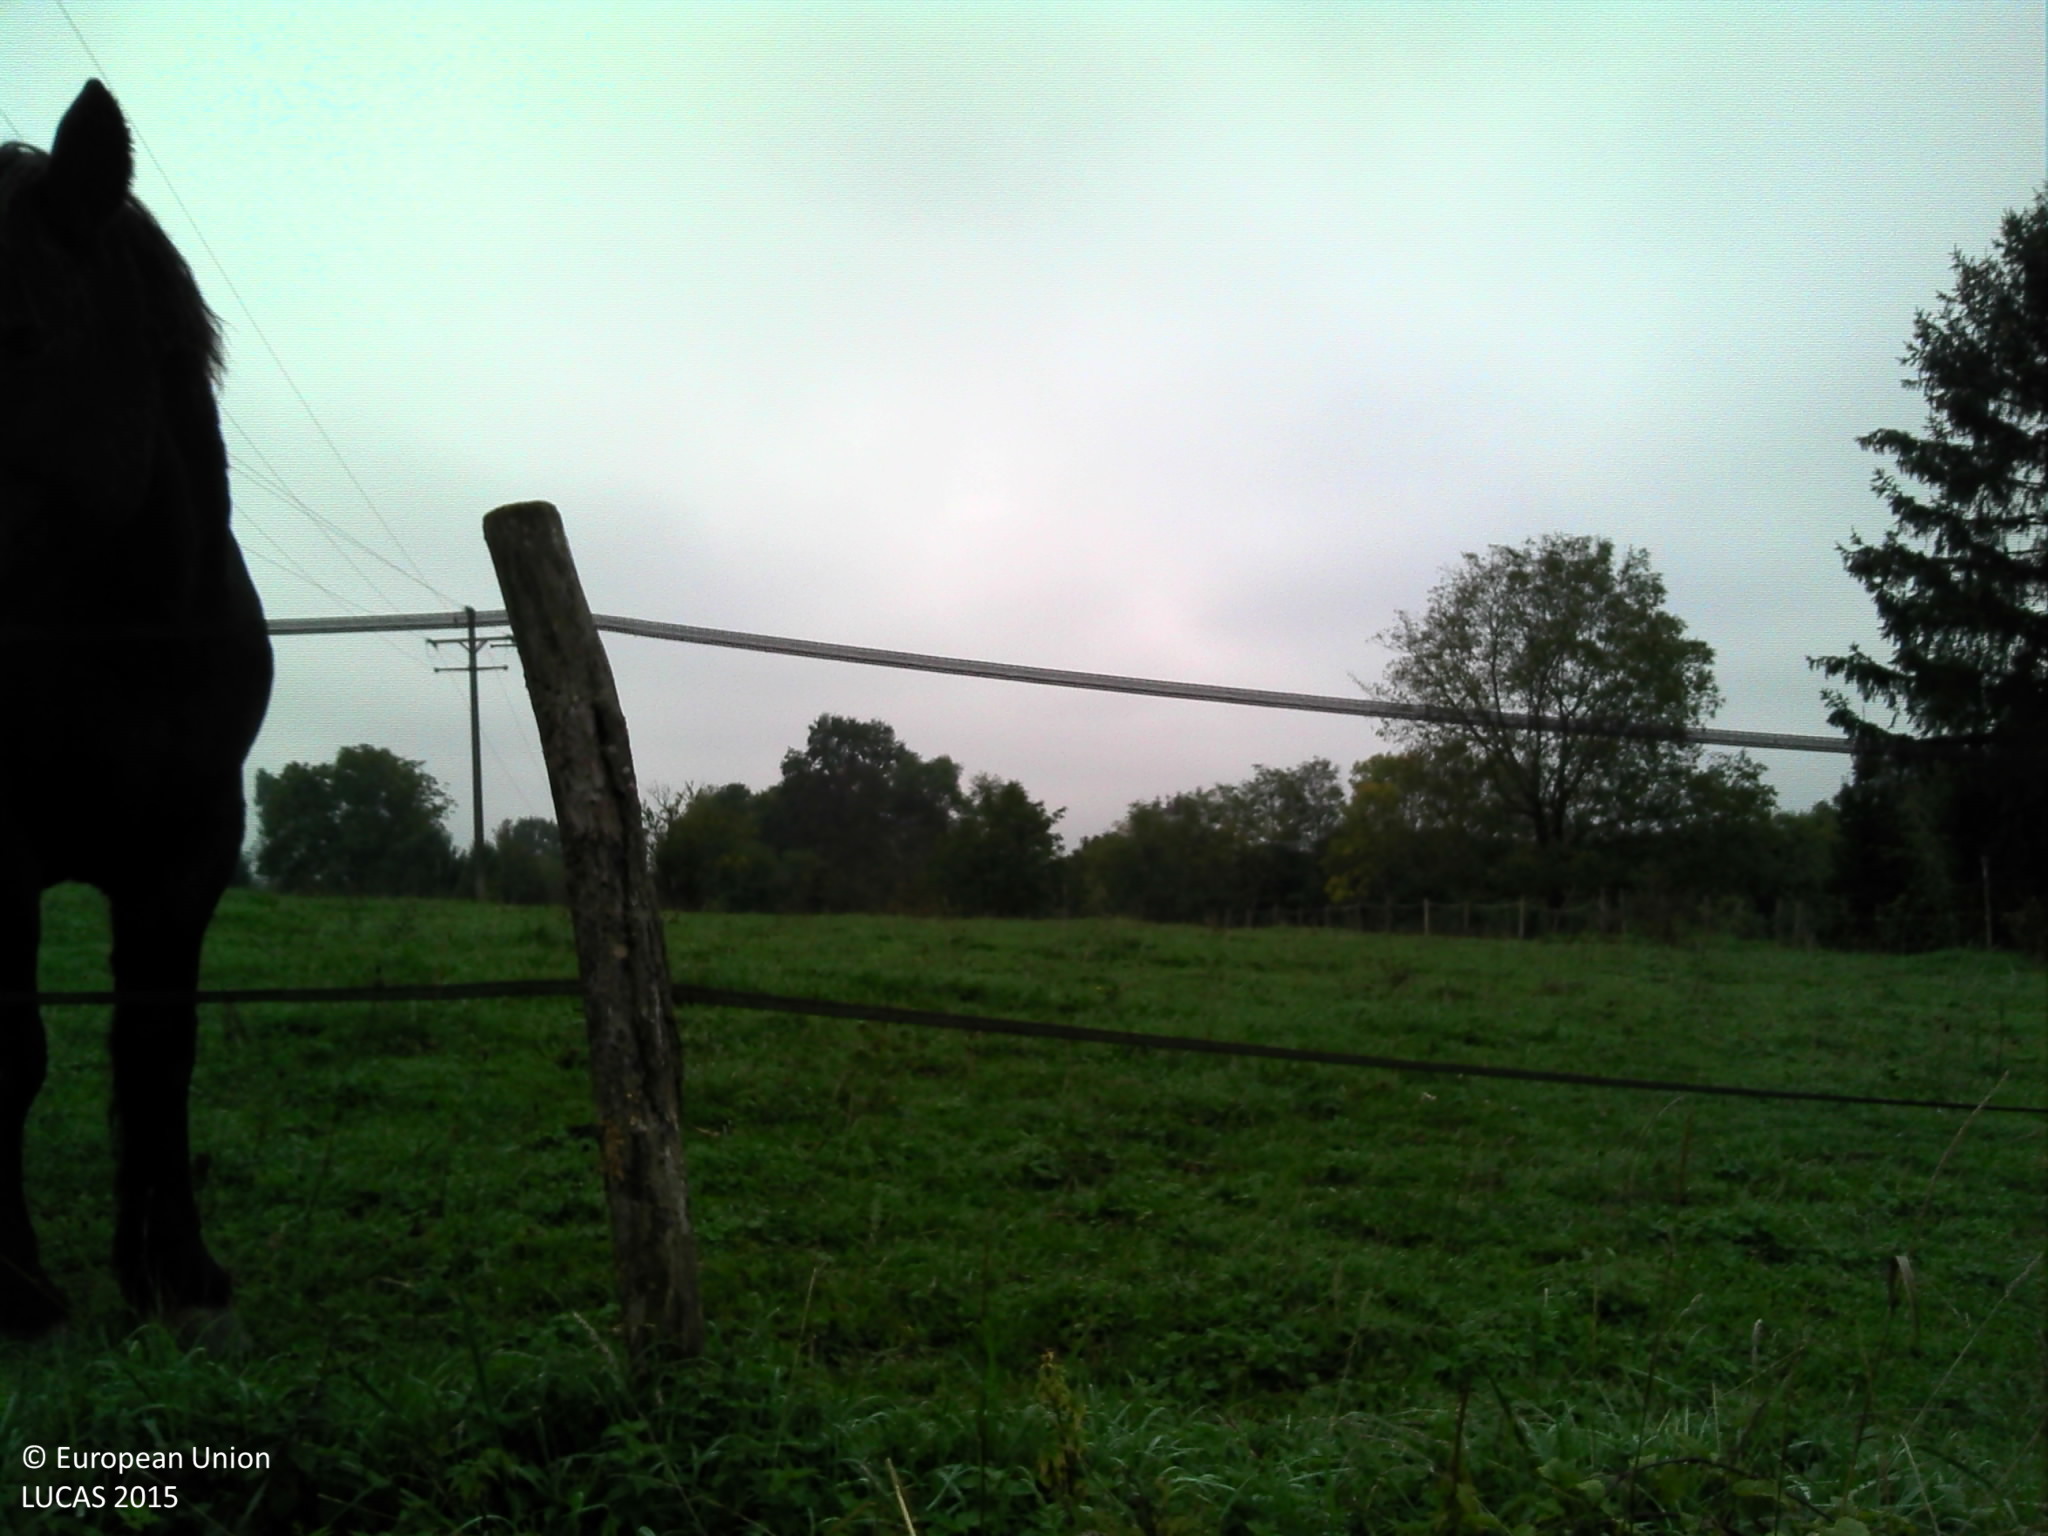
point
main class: Grassland
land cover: Grassland without tree/shrub cover
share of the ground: > 75 %
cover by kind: herbaceous plants 100 %
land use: Agriculture (excluding fallow land and kitchen gardens)
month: October
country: FR
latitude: 46.2503
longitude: 4.9569
